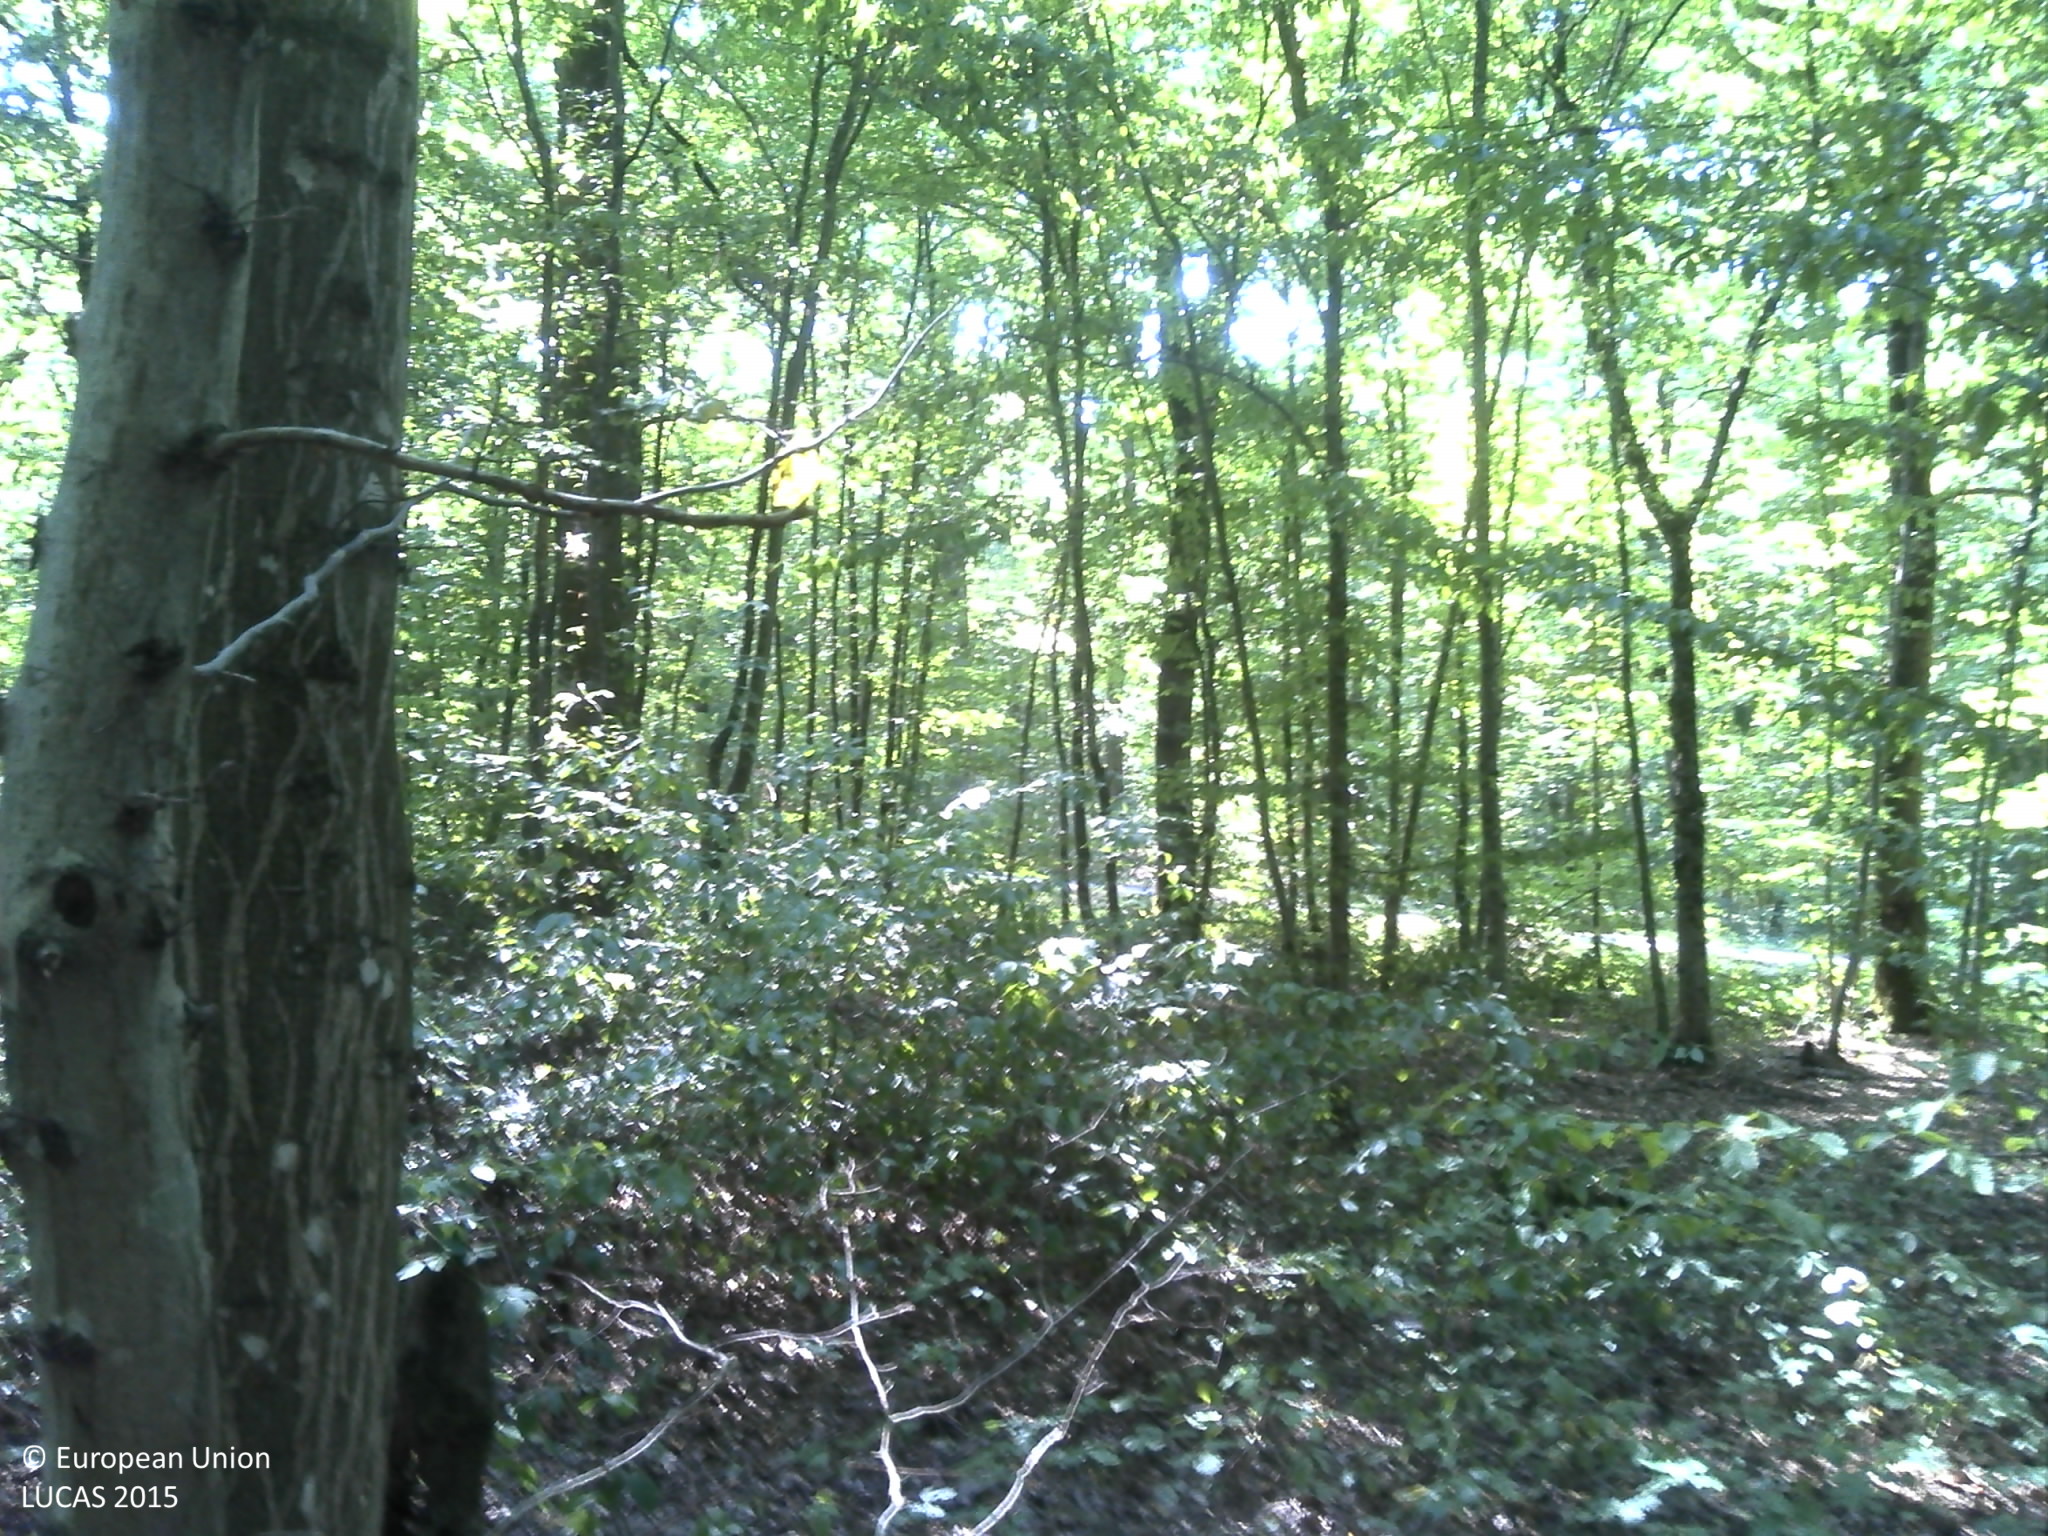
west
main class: Woodland
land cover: Broadleaved woodland
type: mesophytic deciduous forest
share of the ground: > 75 %
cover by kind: broadleaved forest trees 100 %
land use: Forestry
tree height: > 5 m
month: August
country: FR
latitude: 49.3661
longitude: 6.2404
